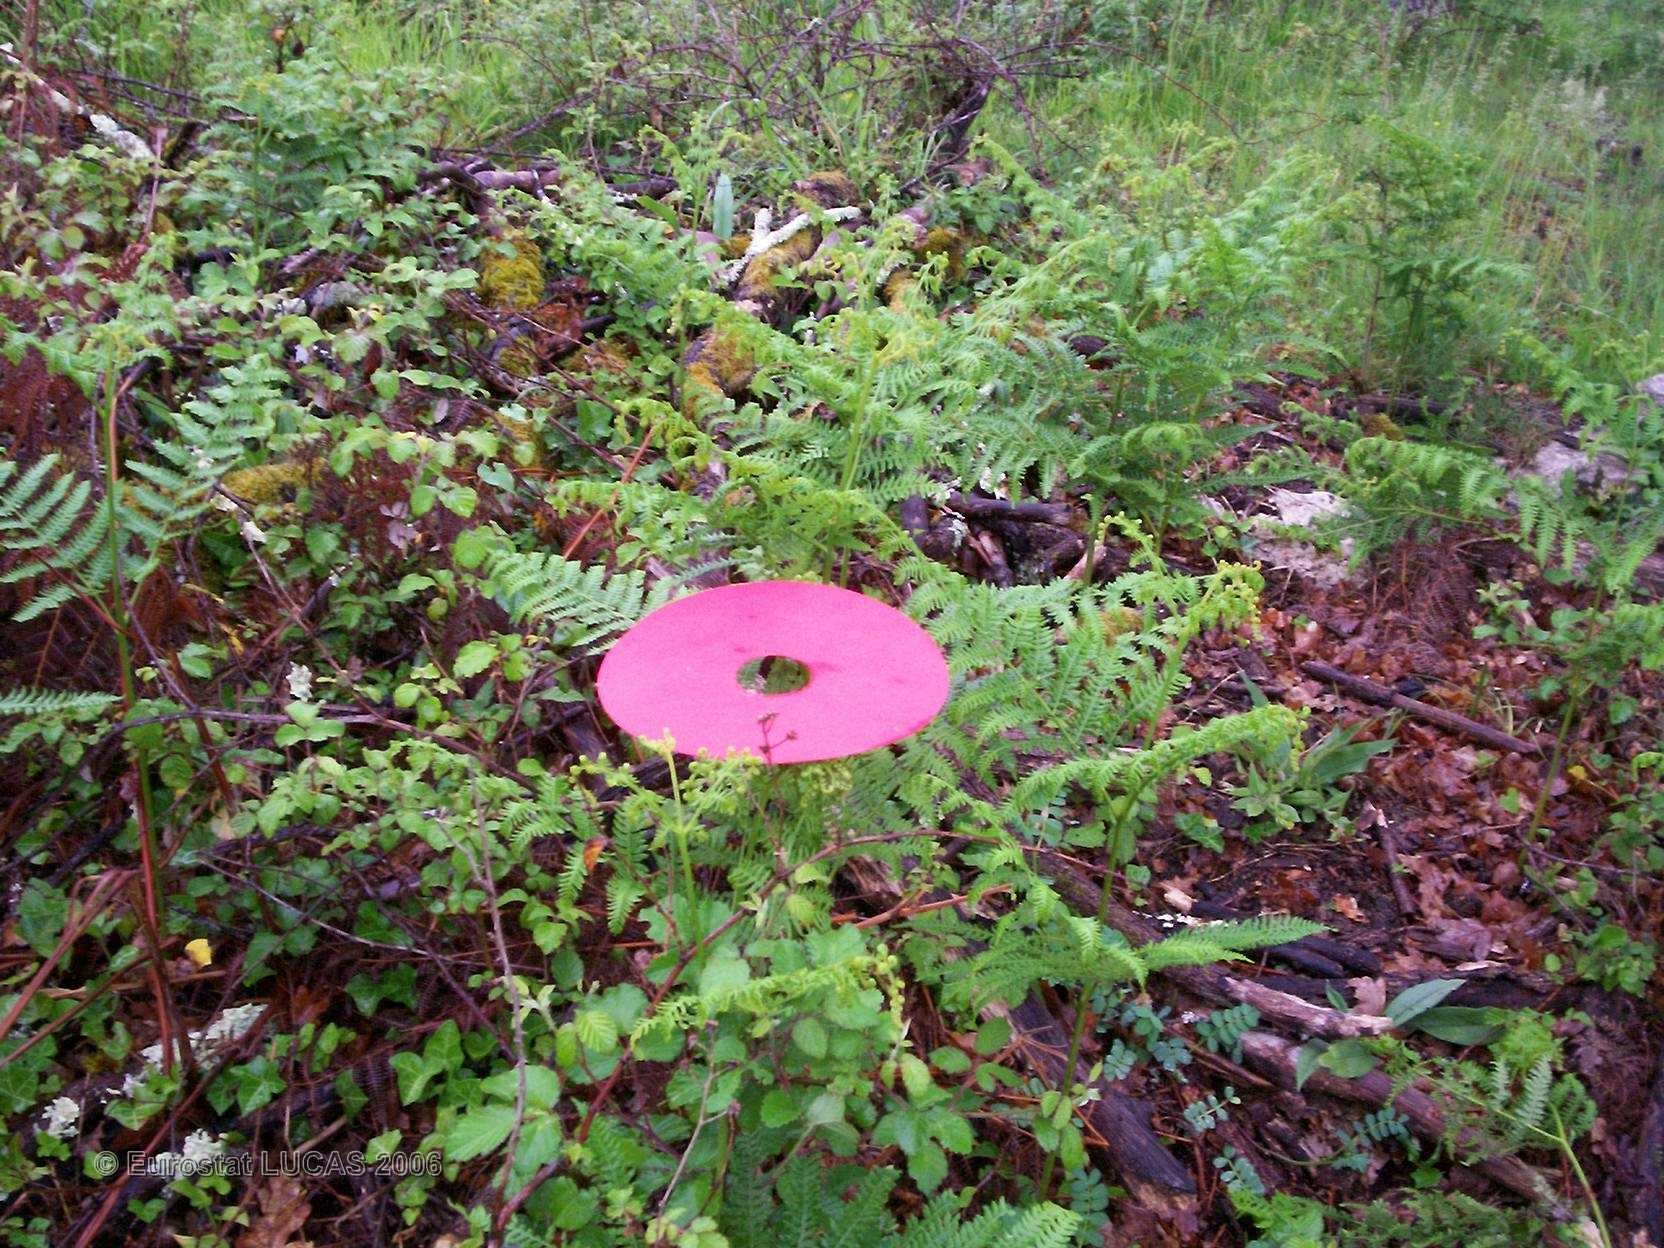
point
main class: Grassland
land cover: Grassland with sparse tree/shrub cover
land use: Agriculture (excluding fallow land and kitchen gardens)
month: May
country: FR
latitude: 45.4058
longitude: 0.5461
